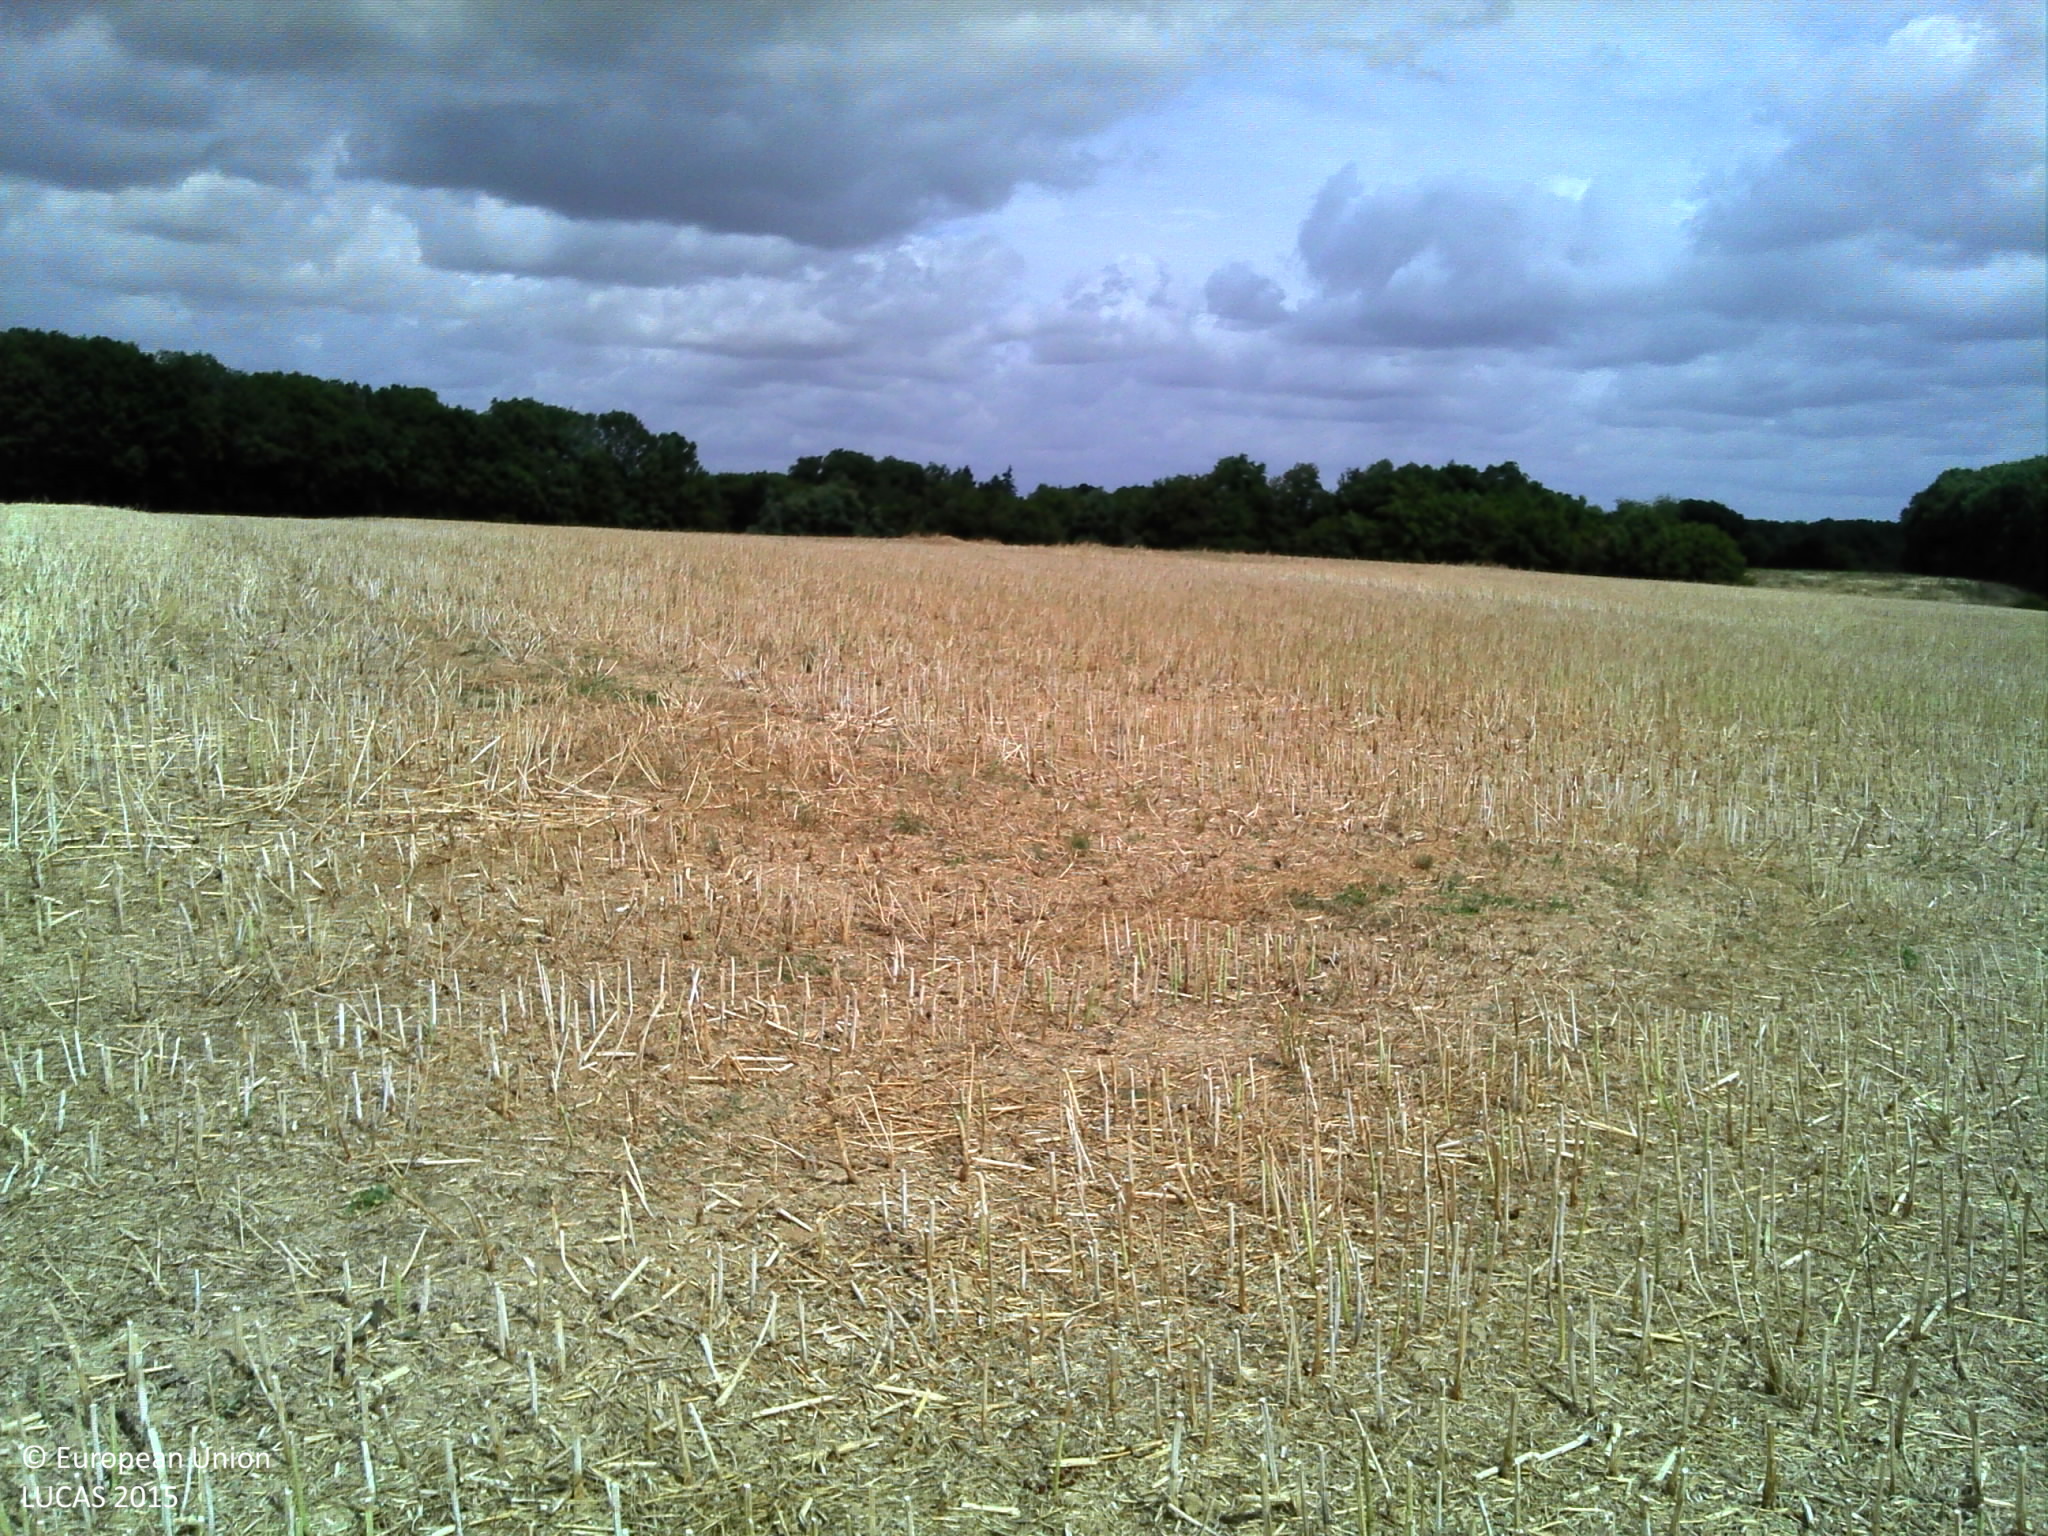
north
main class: Cropland
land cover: Rape and turnip rape
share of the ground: > 75 %
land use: Agriculture (excluding fallow land and kitchen gardens)
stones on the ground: < 10 %
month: July
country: FR
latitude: 47.8779
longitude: 3.0538
